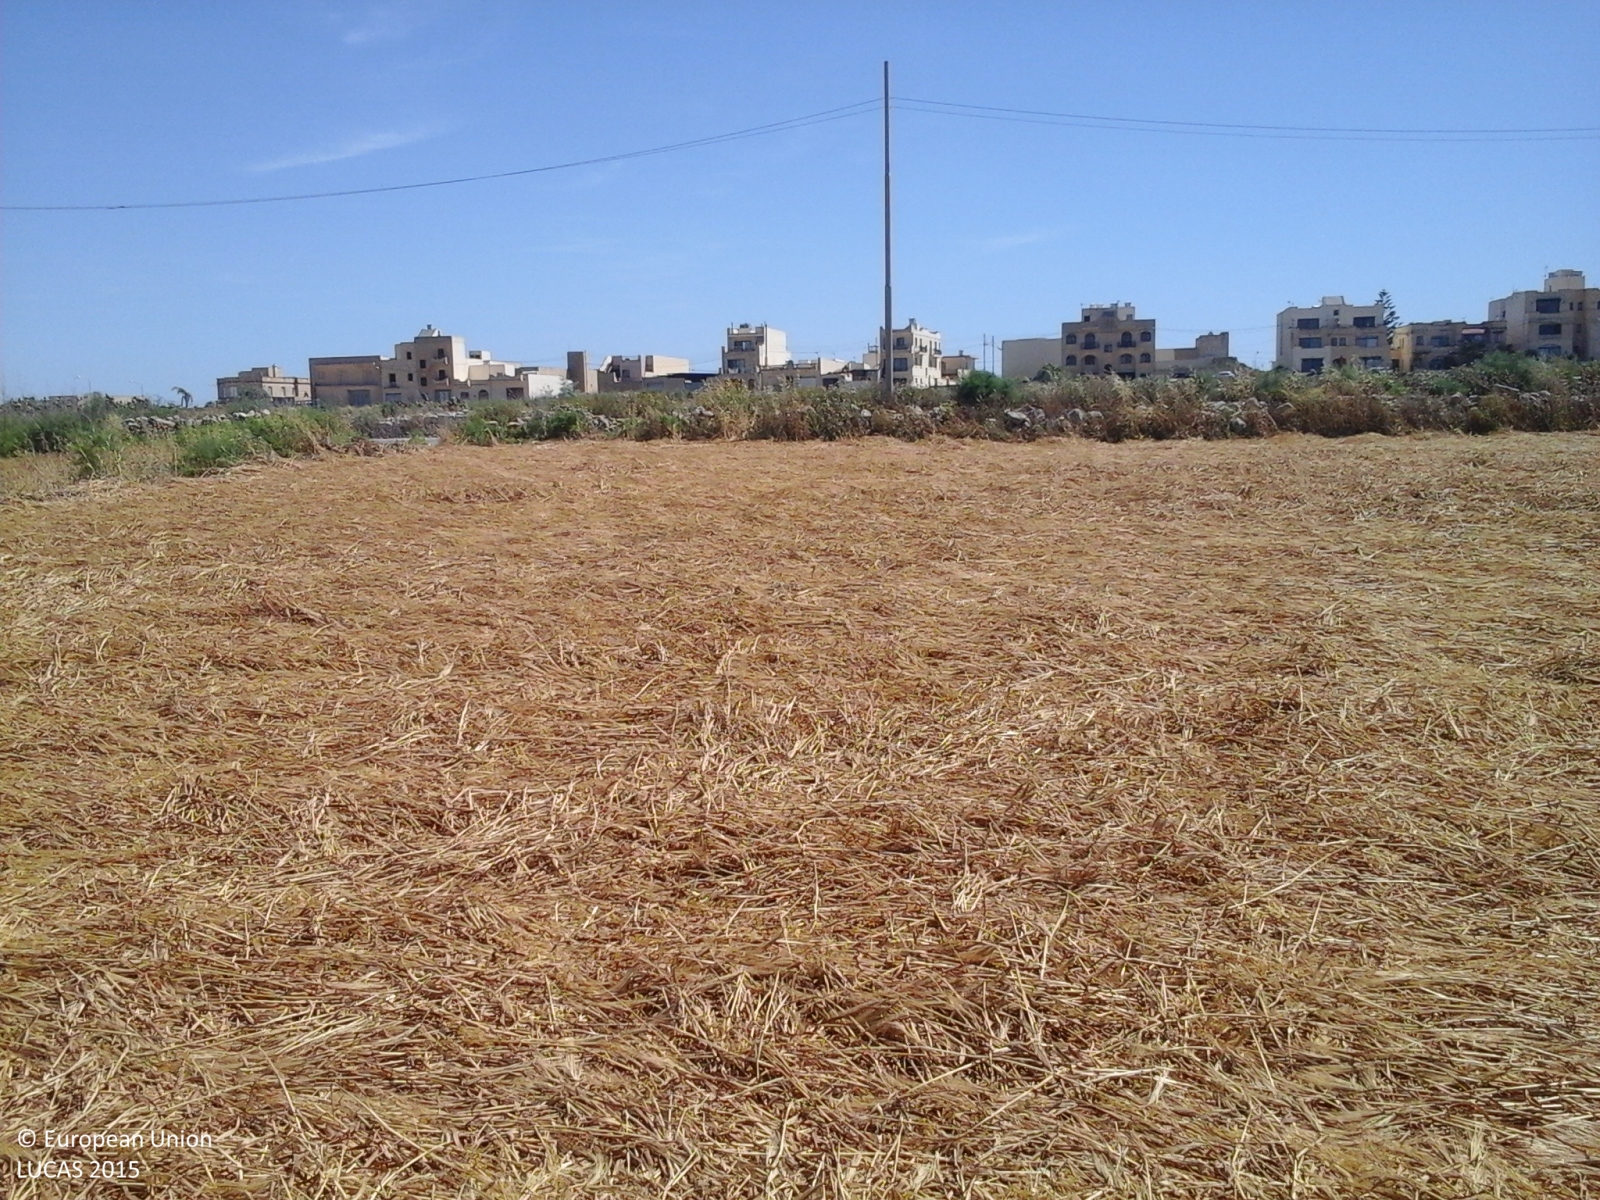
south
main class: Cropland
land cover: Mixed cereals for fodder
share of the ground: > 75 %
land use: Agriculture (excluding fallow land and kitchen gardens)
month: May
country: MT
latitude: 36.0320
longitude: 14.2781
